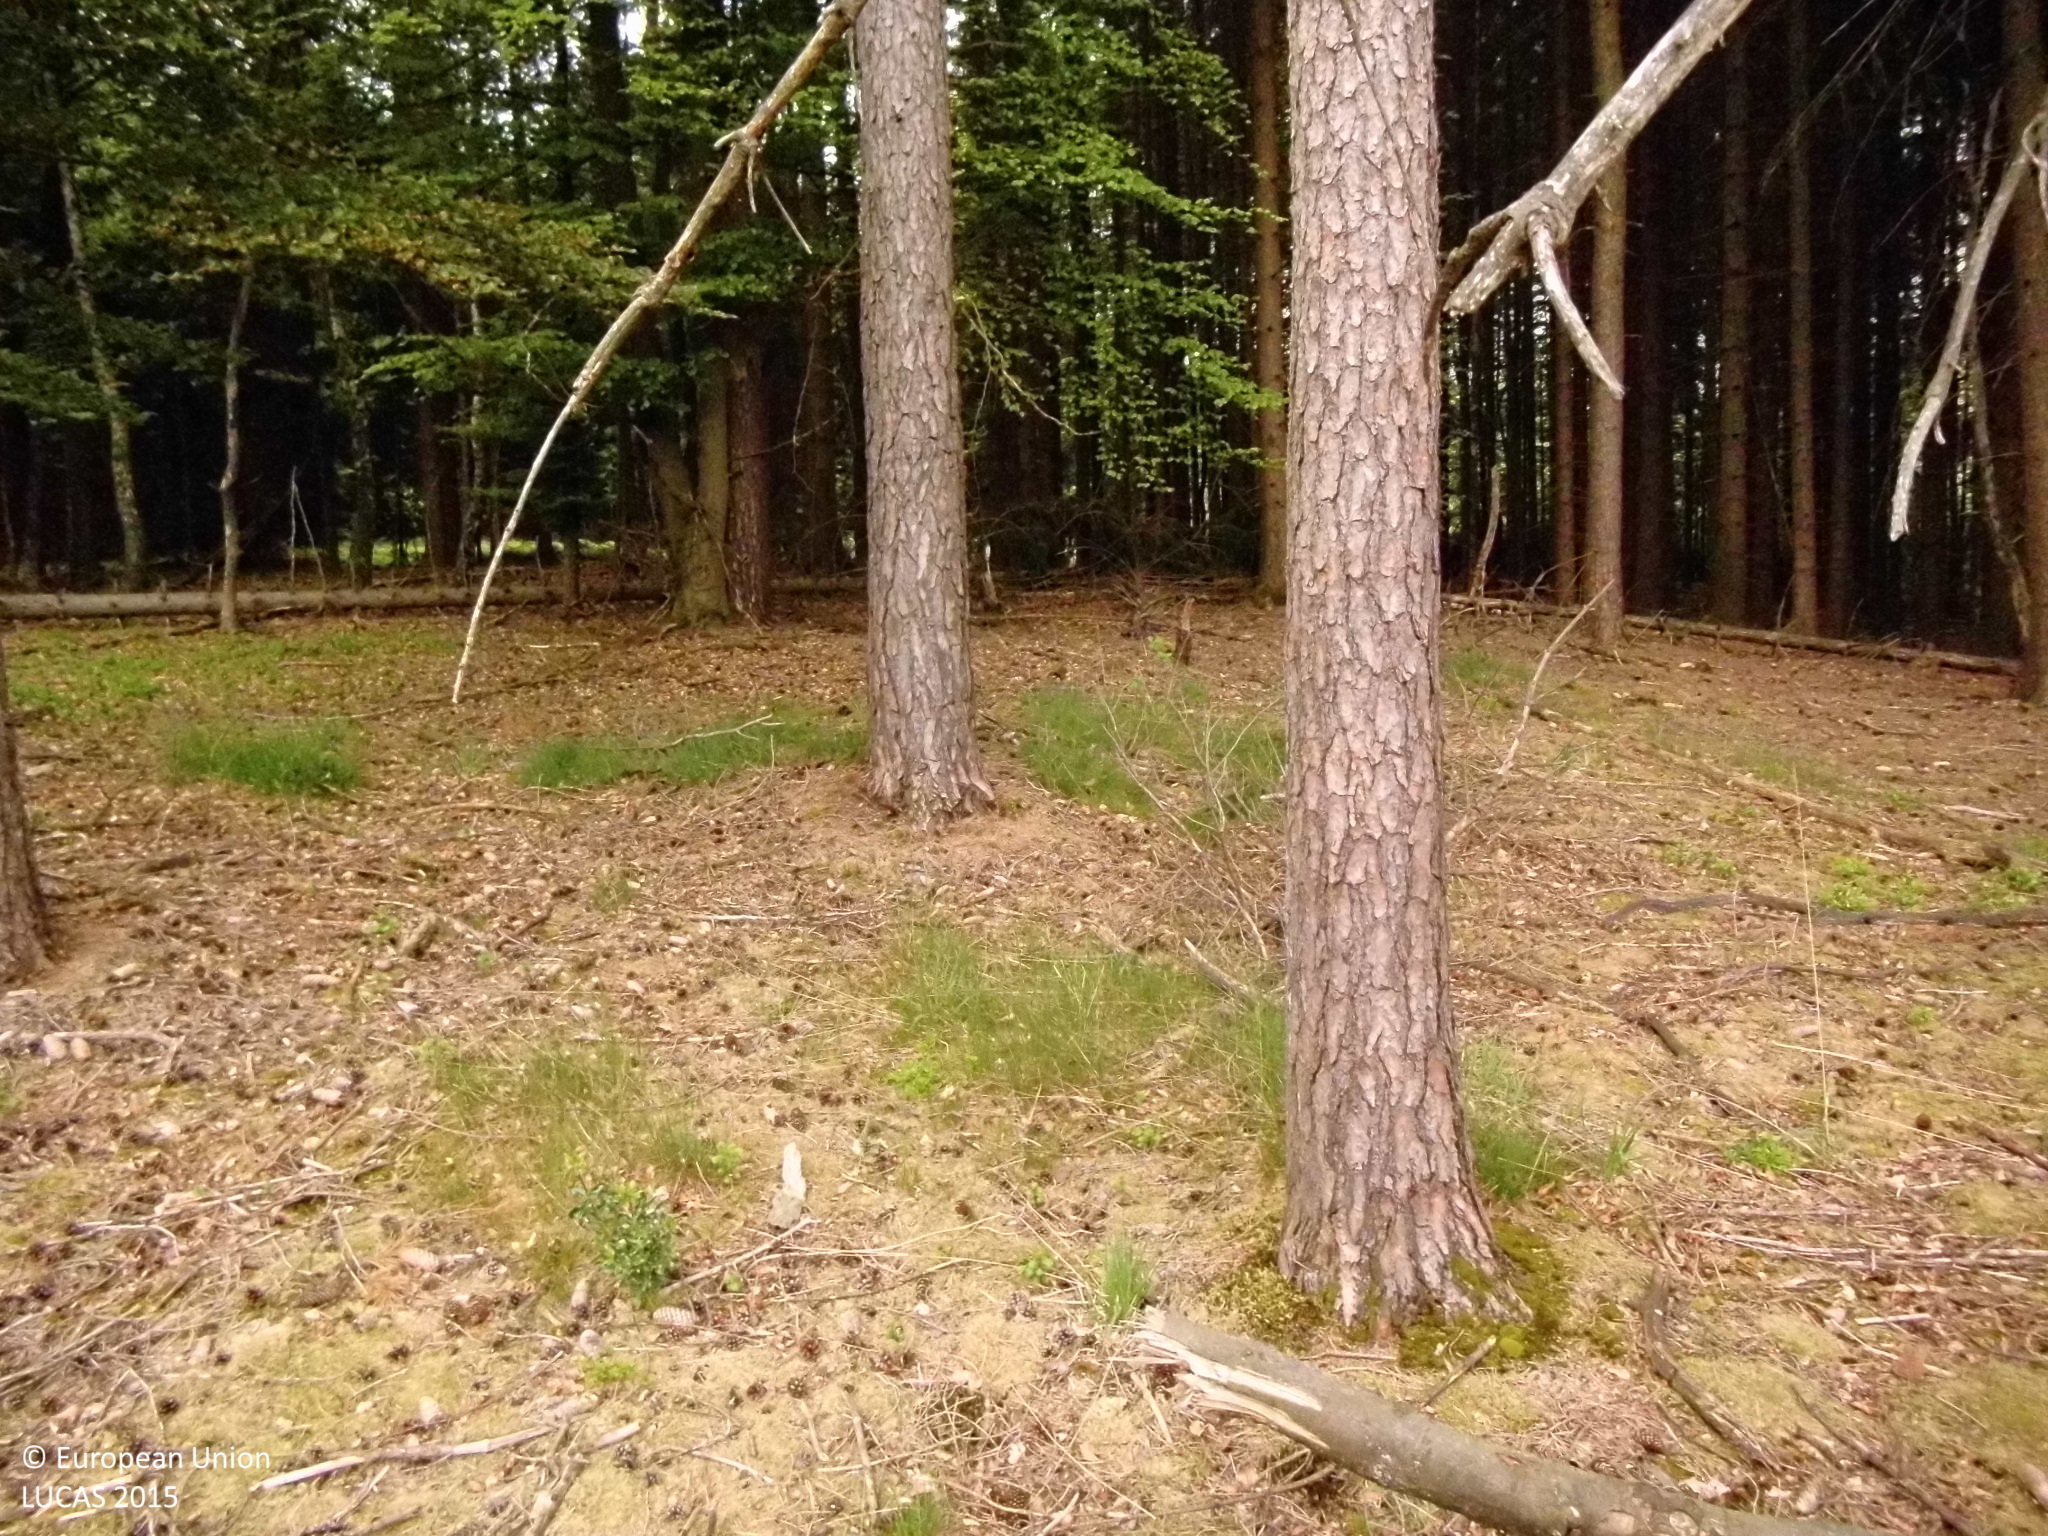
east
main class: Woodland
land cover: Other mixed woodland
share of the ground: > 75 %
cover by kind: coniferous forest trees 40 %, broadleaved forest trees 40 %, lichens and mosses 10 %, herbaceous plants 5 %, unconsolidated bare surface 5 %
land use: Forestry
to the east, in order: Other mixed woodland; Spruce dominated coniferous woodland; Broadleaved woodland; Shrubland with sparse tree cover; Broadleaved woodland; Shruby margins; Ditches and canals; Shruby margins; Grass margins; Paved roads, cycling and walking lanes; Grass margins; Ditches and canals; Broadleaved woodland
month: May
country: DE
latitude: 50.9120
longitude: 7.4828
